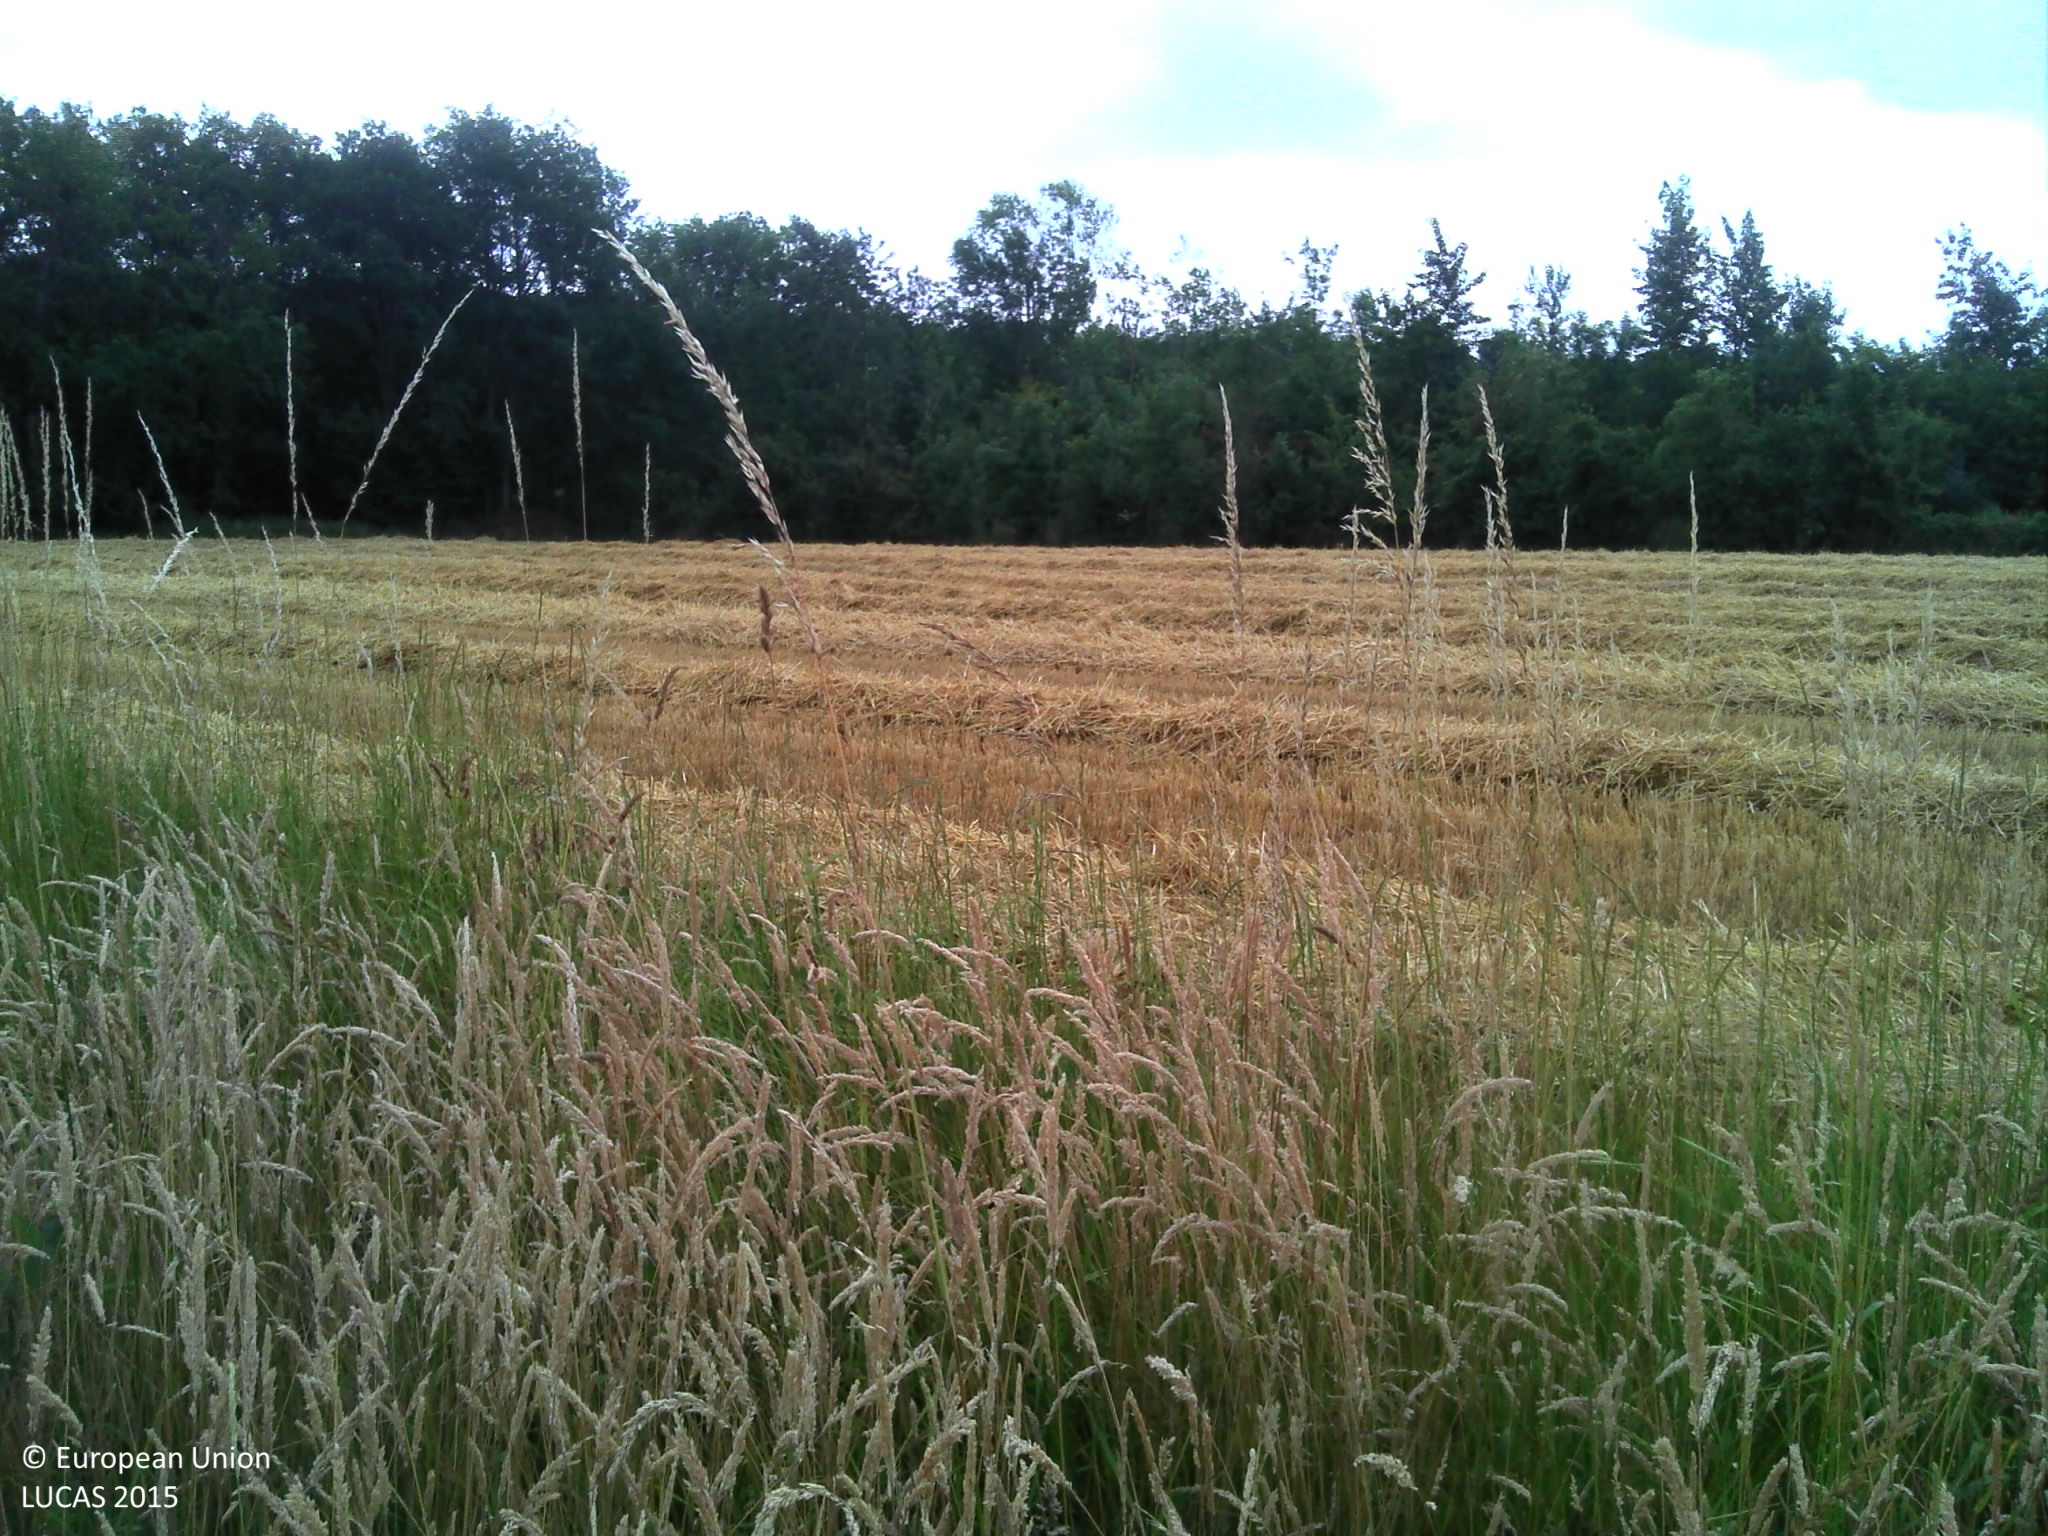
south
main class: Grassland
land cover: Grassland without tree/shrub cover
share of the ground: > 75 %
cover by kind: herbaceous plants 100 %
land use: Agriculture (excluding fallow land and kitchen gardens)
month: June
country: FR
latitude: 47.8356
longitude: 3.5425
